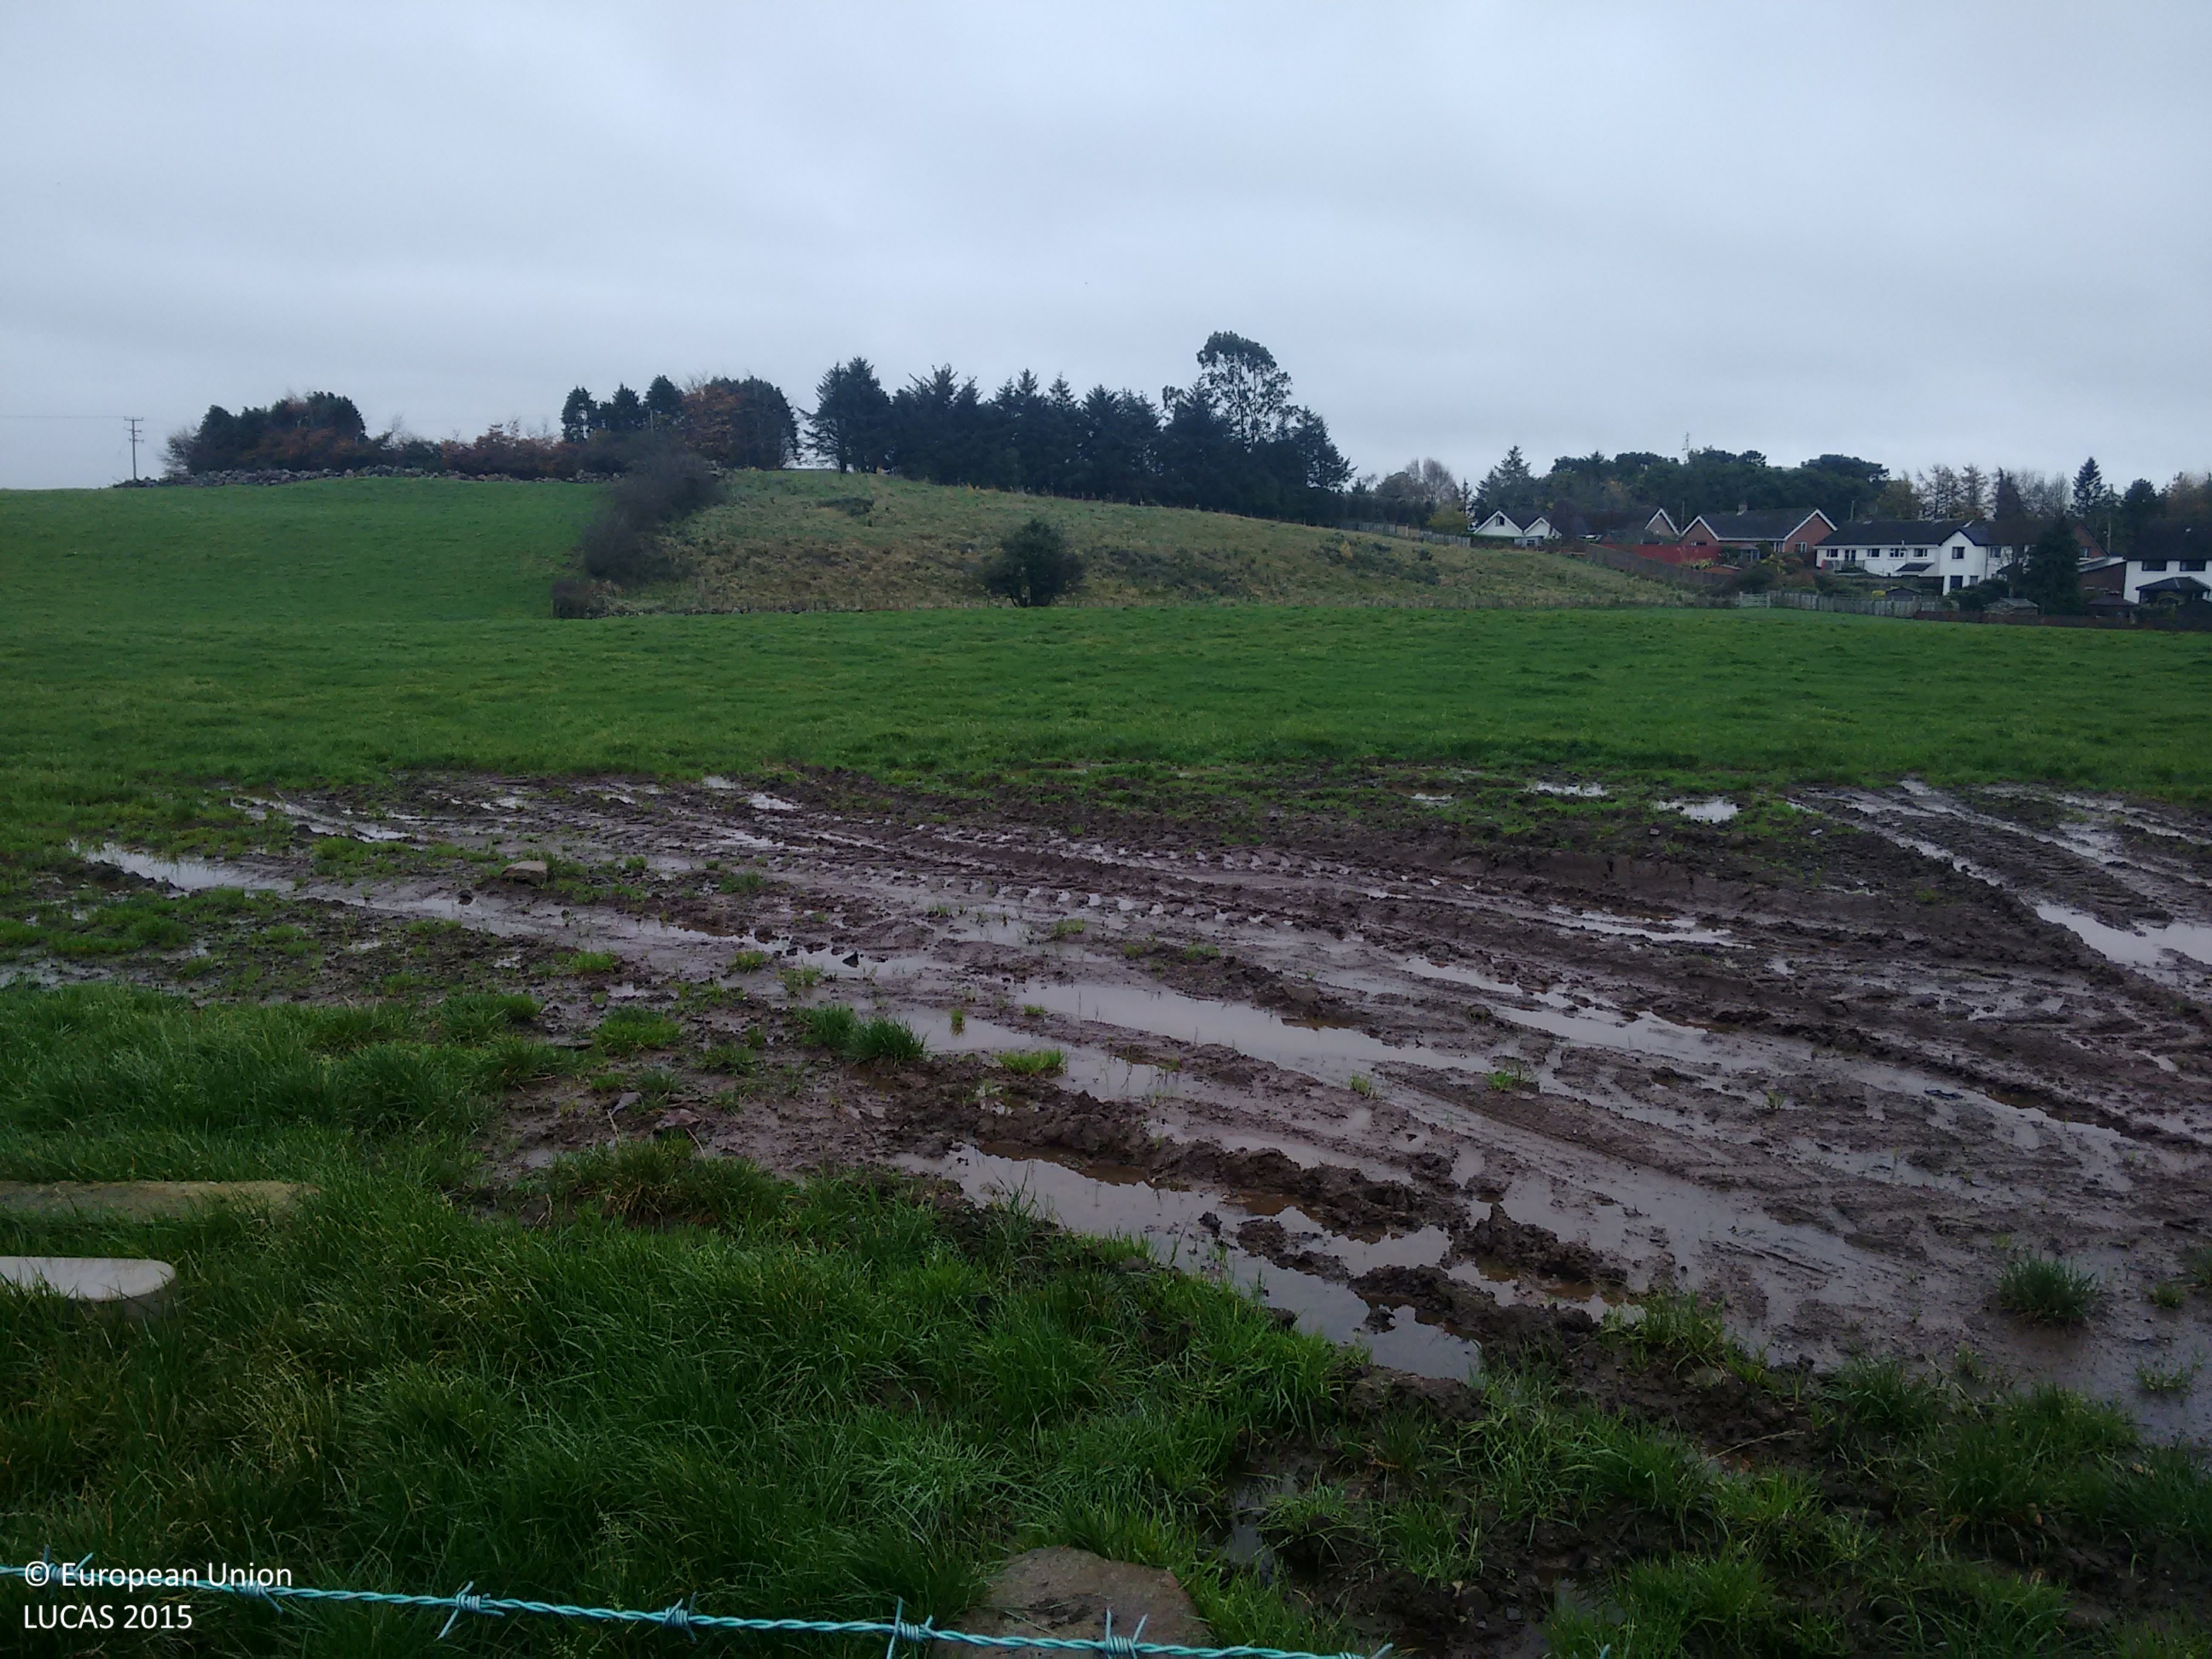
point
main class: Grassland
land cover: Grassland without tree/shrub cover
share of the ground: > 75 %
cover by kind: herbaceous plants 100 %
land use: Agriculture (excluding fallow land and kitchen gardens)
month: November
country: GB
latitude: 54.5998
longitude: -5.7523
